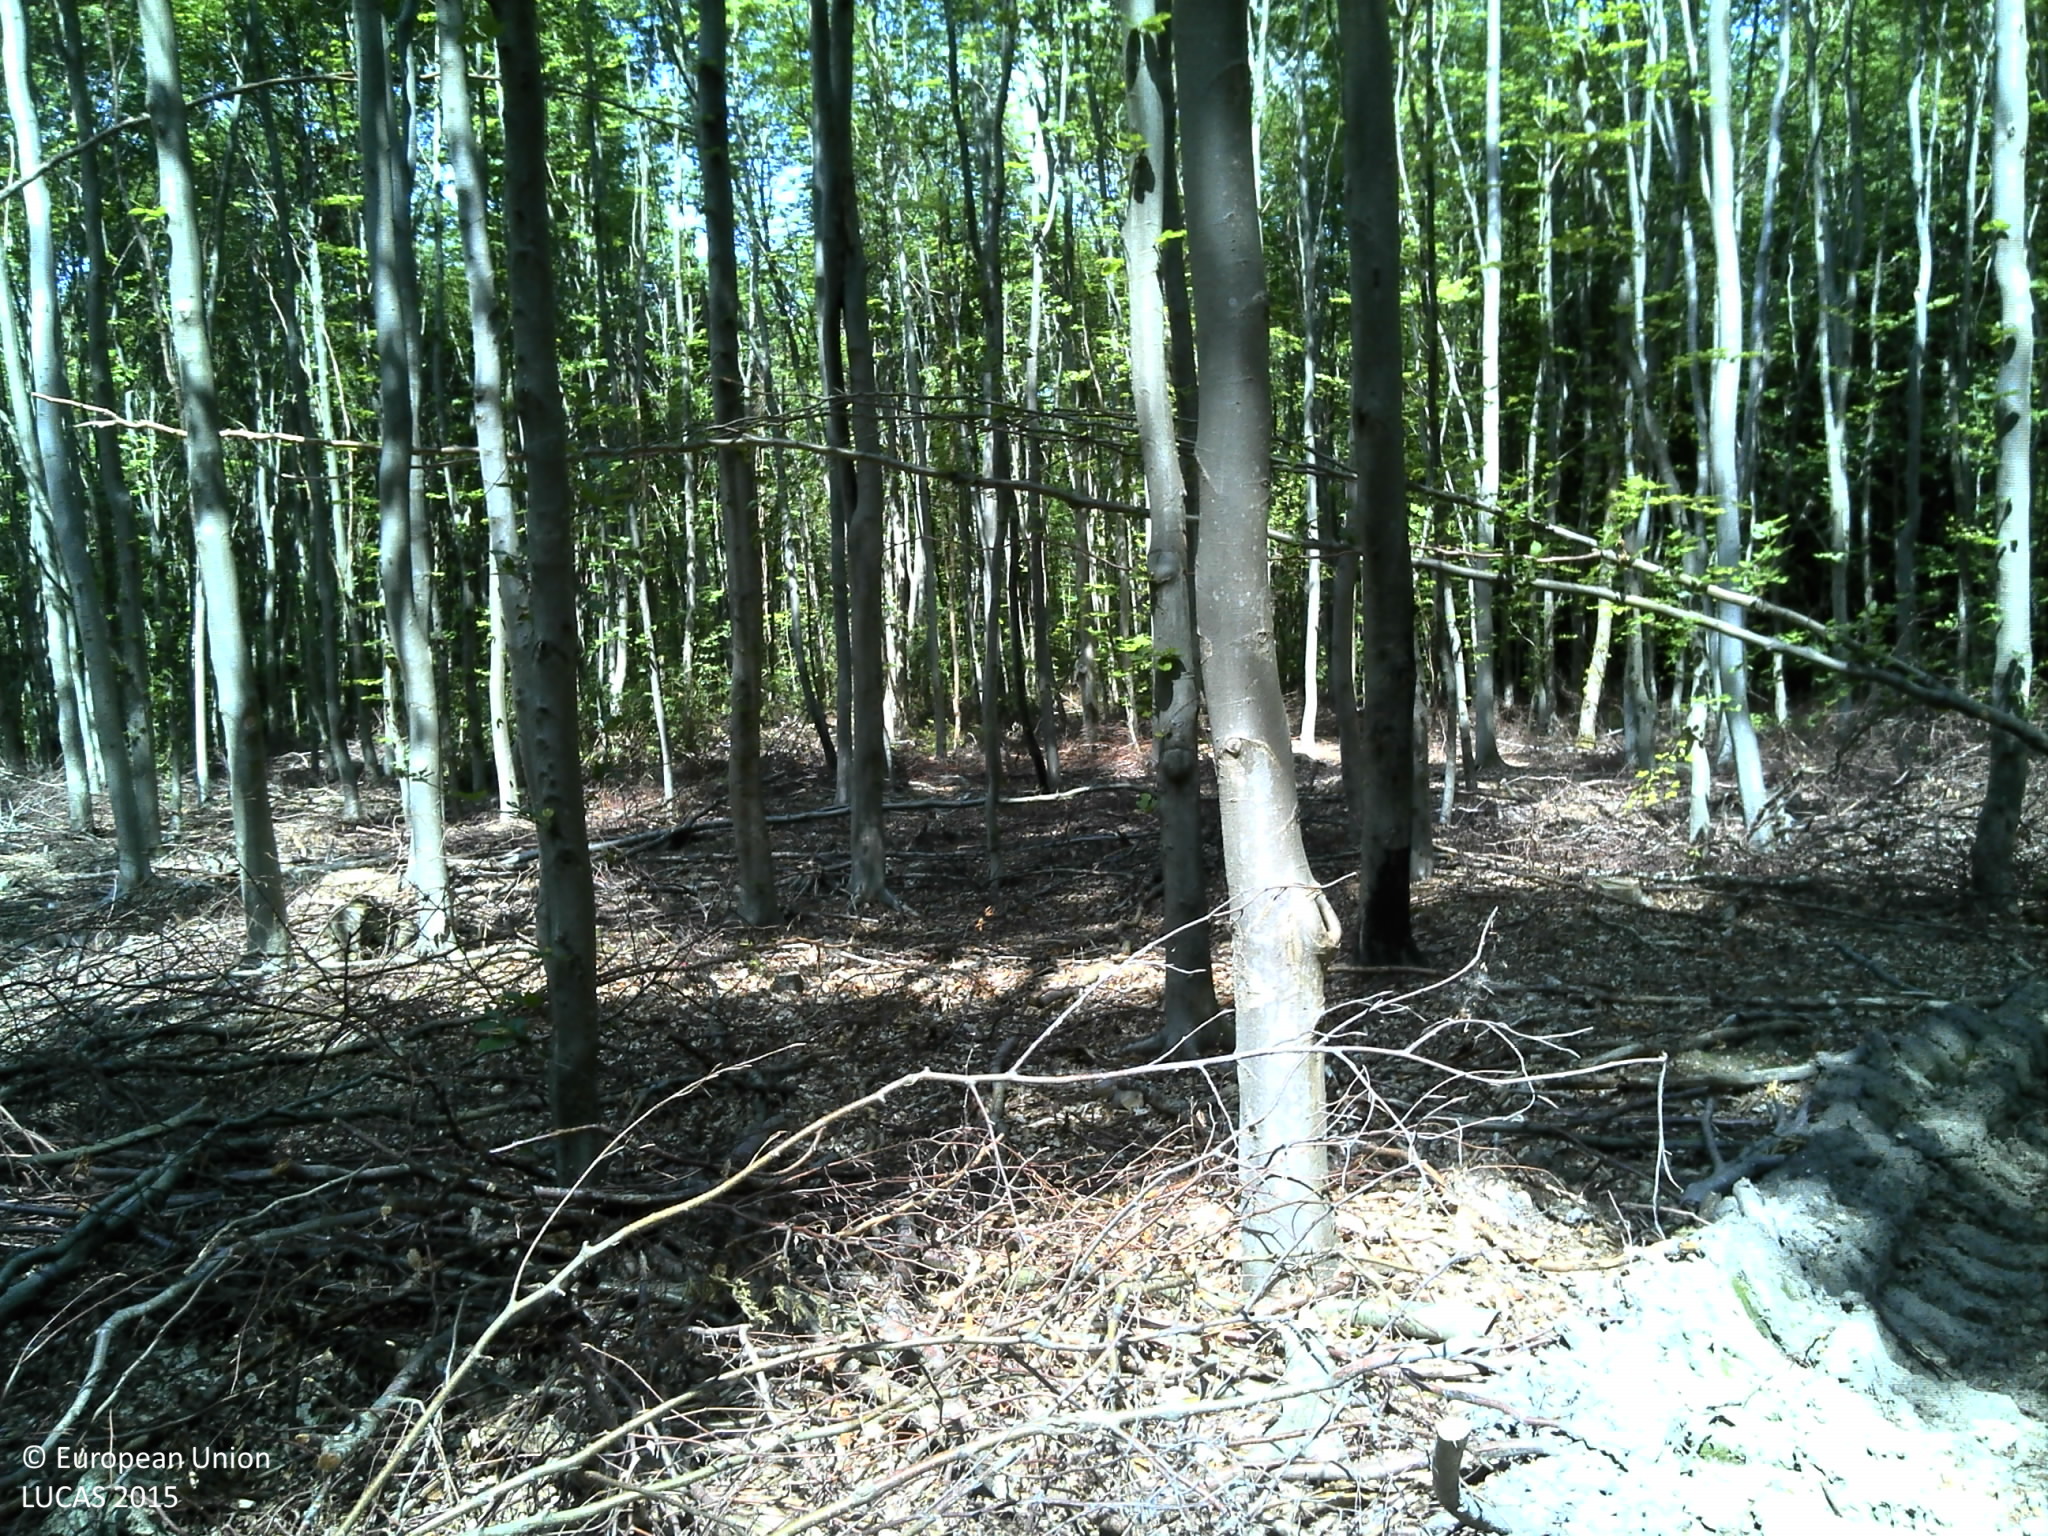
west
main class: Woodland
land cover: Broadleaved woodland
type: beech forest
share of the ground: > 75 %
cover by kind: broadleaved forest trees 90 %, consolidated bare surface 10 %
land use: Forestry
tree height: > 5 m
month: June
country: FR
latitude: 49.5098
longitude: 1.0982
